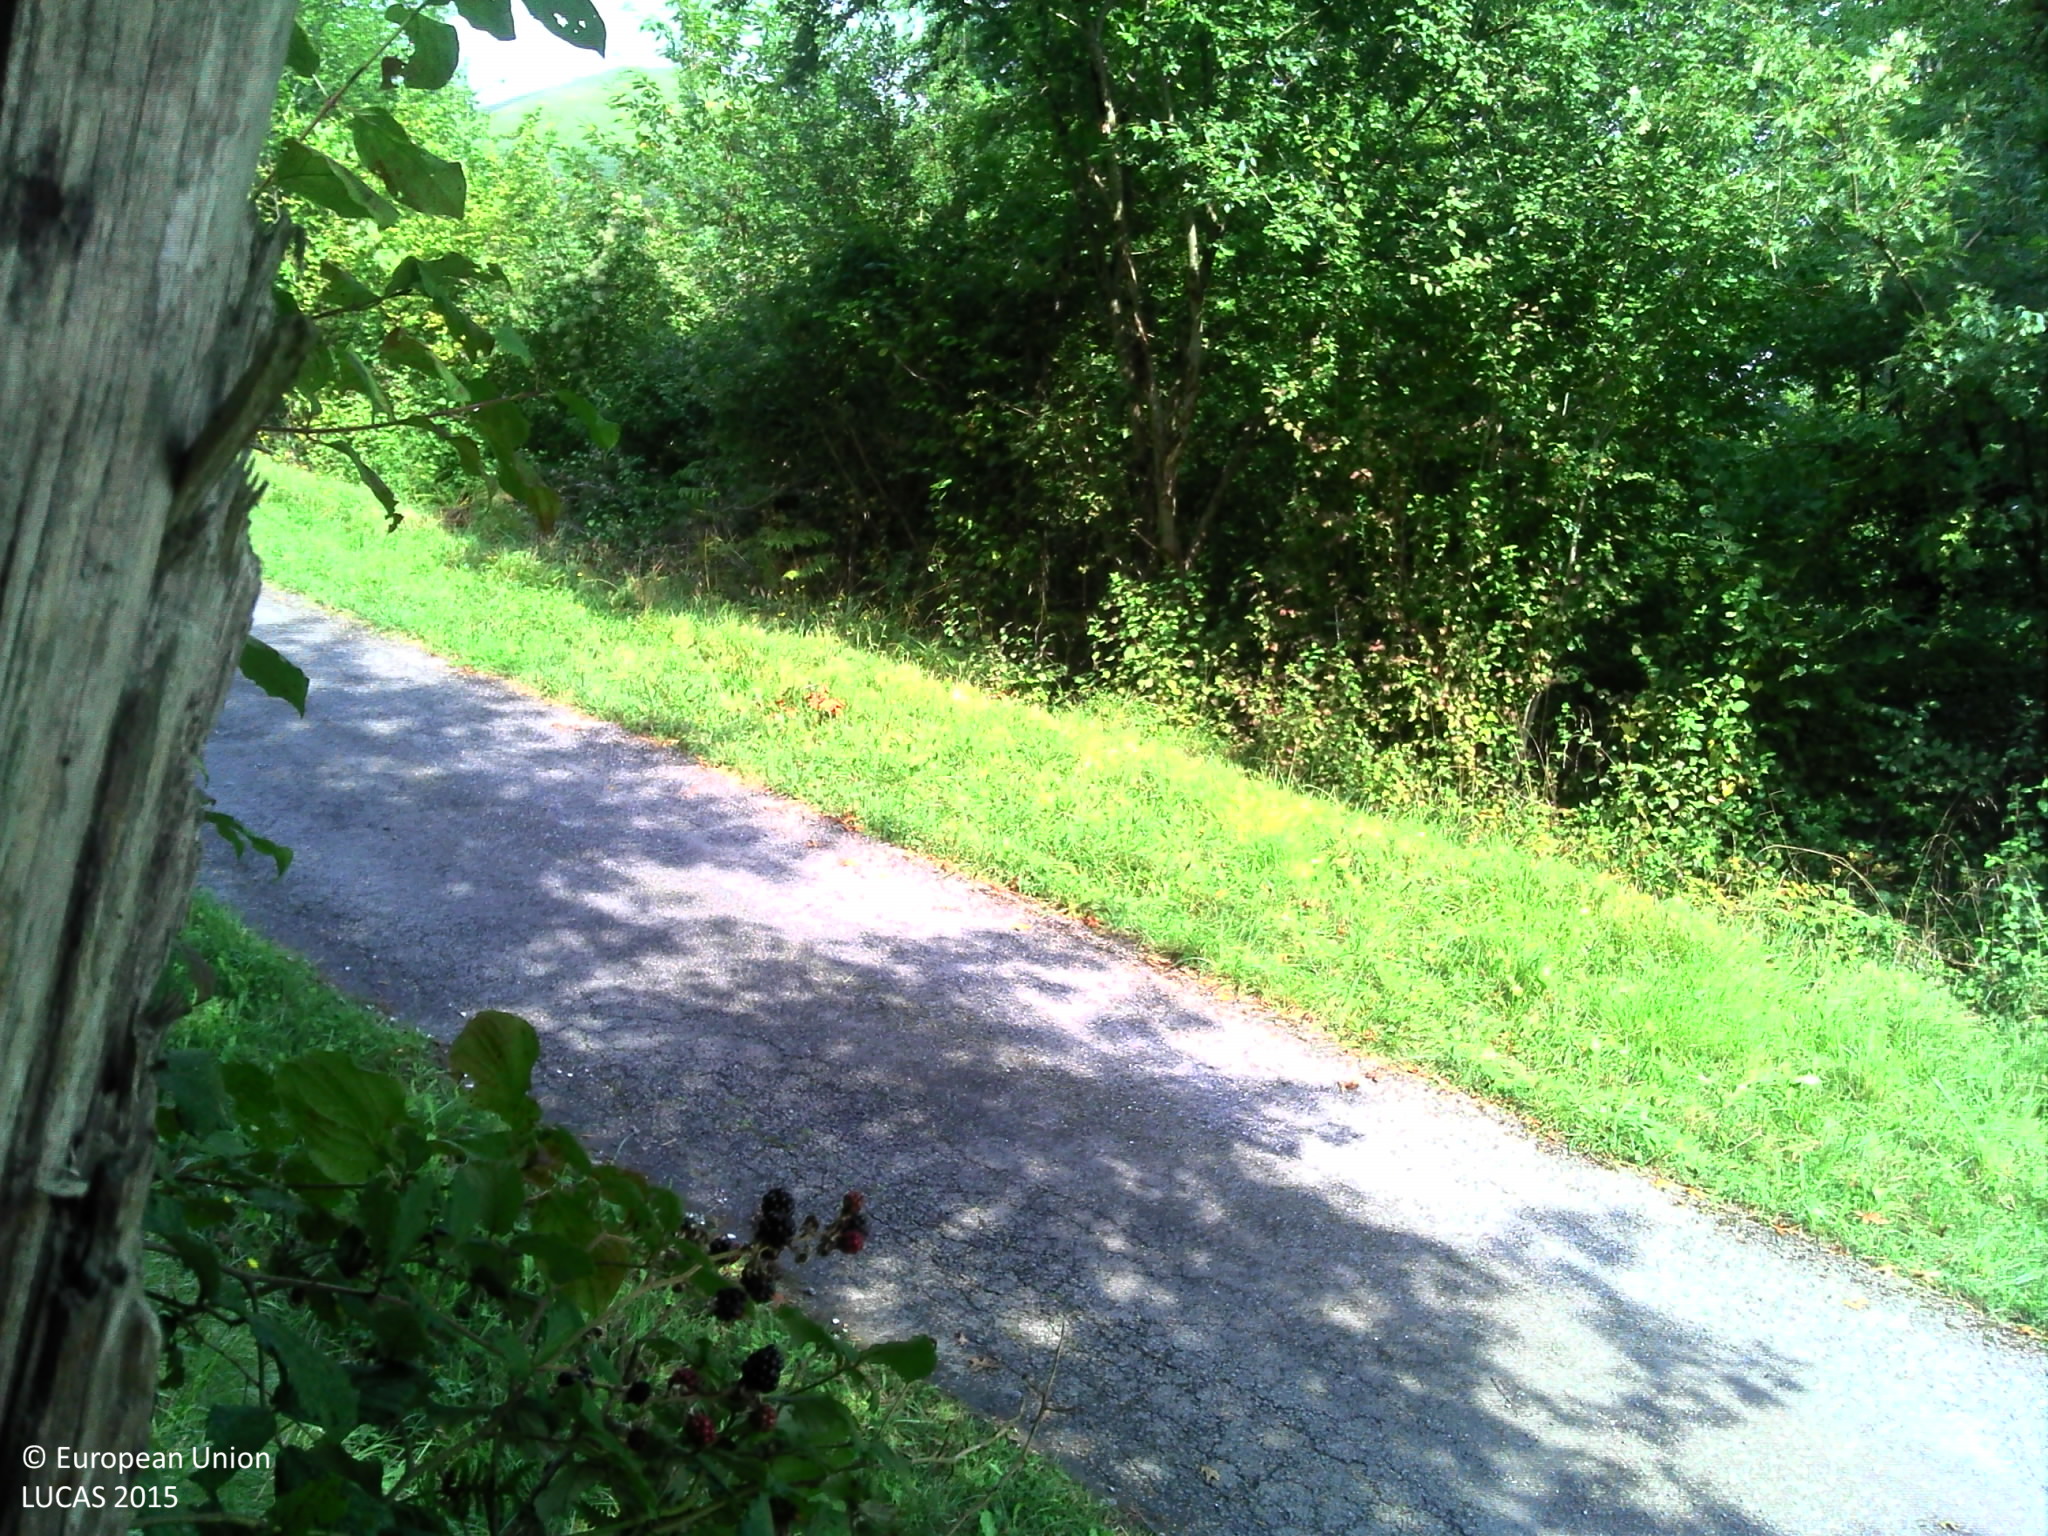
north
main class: Woodland
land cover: Broadleaved woodland
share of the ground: > 75 %
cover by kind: broadleaved forest trees 60 %, shrubs 30 %, herbaceous plants 5 %, lichens and mosses 5 %
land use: Forestry
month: September
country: FR
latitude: 43.1972
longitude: -1.0256
